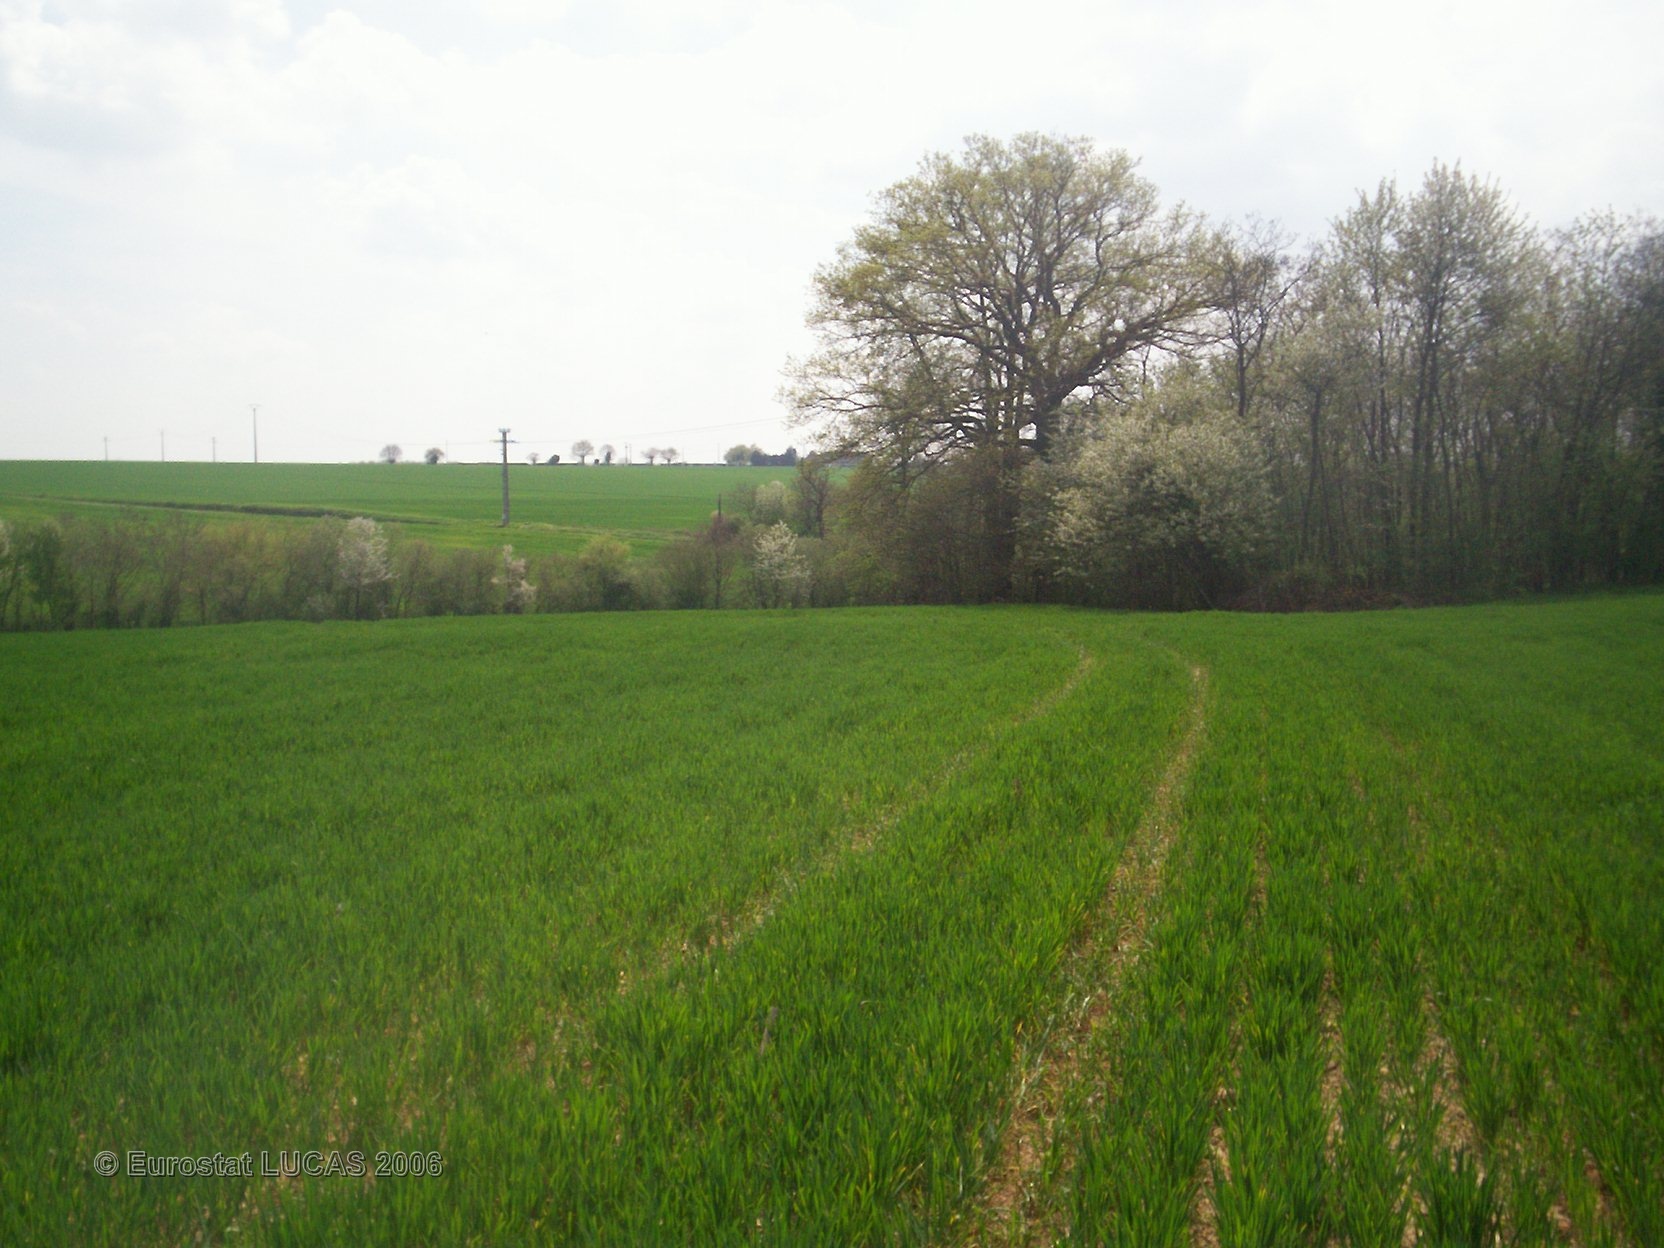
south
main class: Cropland
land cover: Common wheat
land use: Agriculture (excluding fallow land and kitchen gardens)
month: April
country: FR
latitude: 47.8382
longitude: 0.8008
